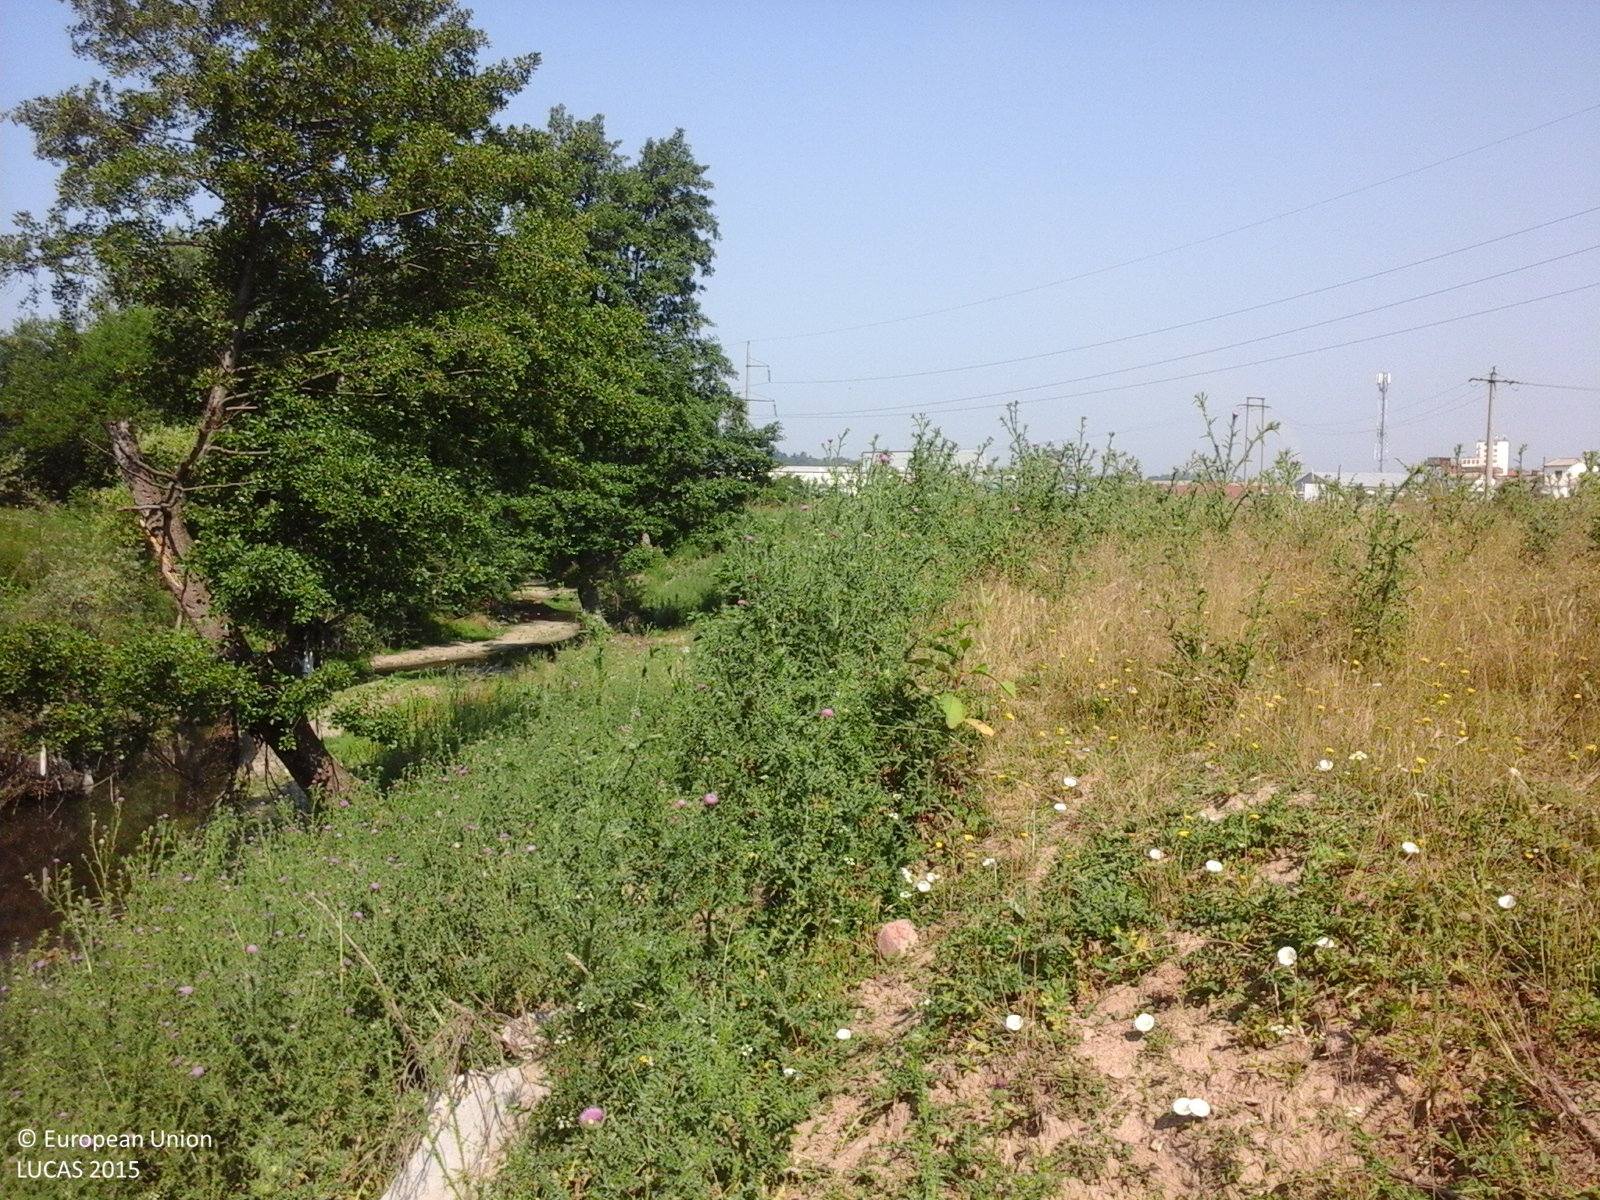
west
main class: Grassland
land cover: Spontaneously vegetated surfaces
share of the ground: > 75 %
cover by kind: herbaceous plants 100 %
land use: Semi-natural and natural areas not in use
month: July
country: RO
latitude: 44.8891
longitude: 24.8317
